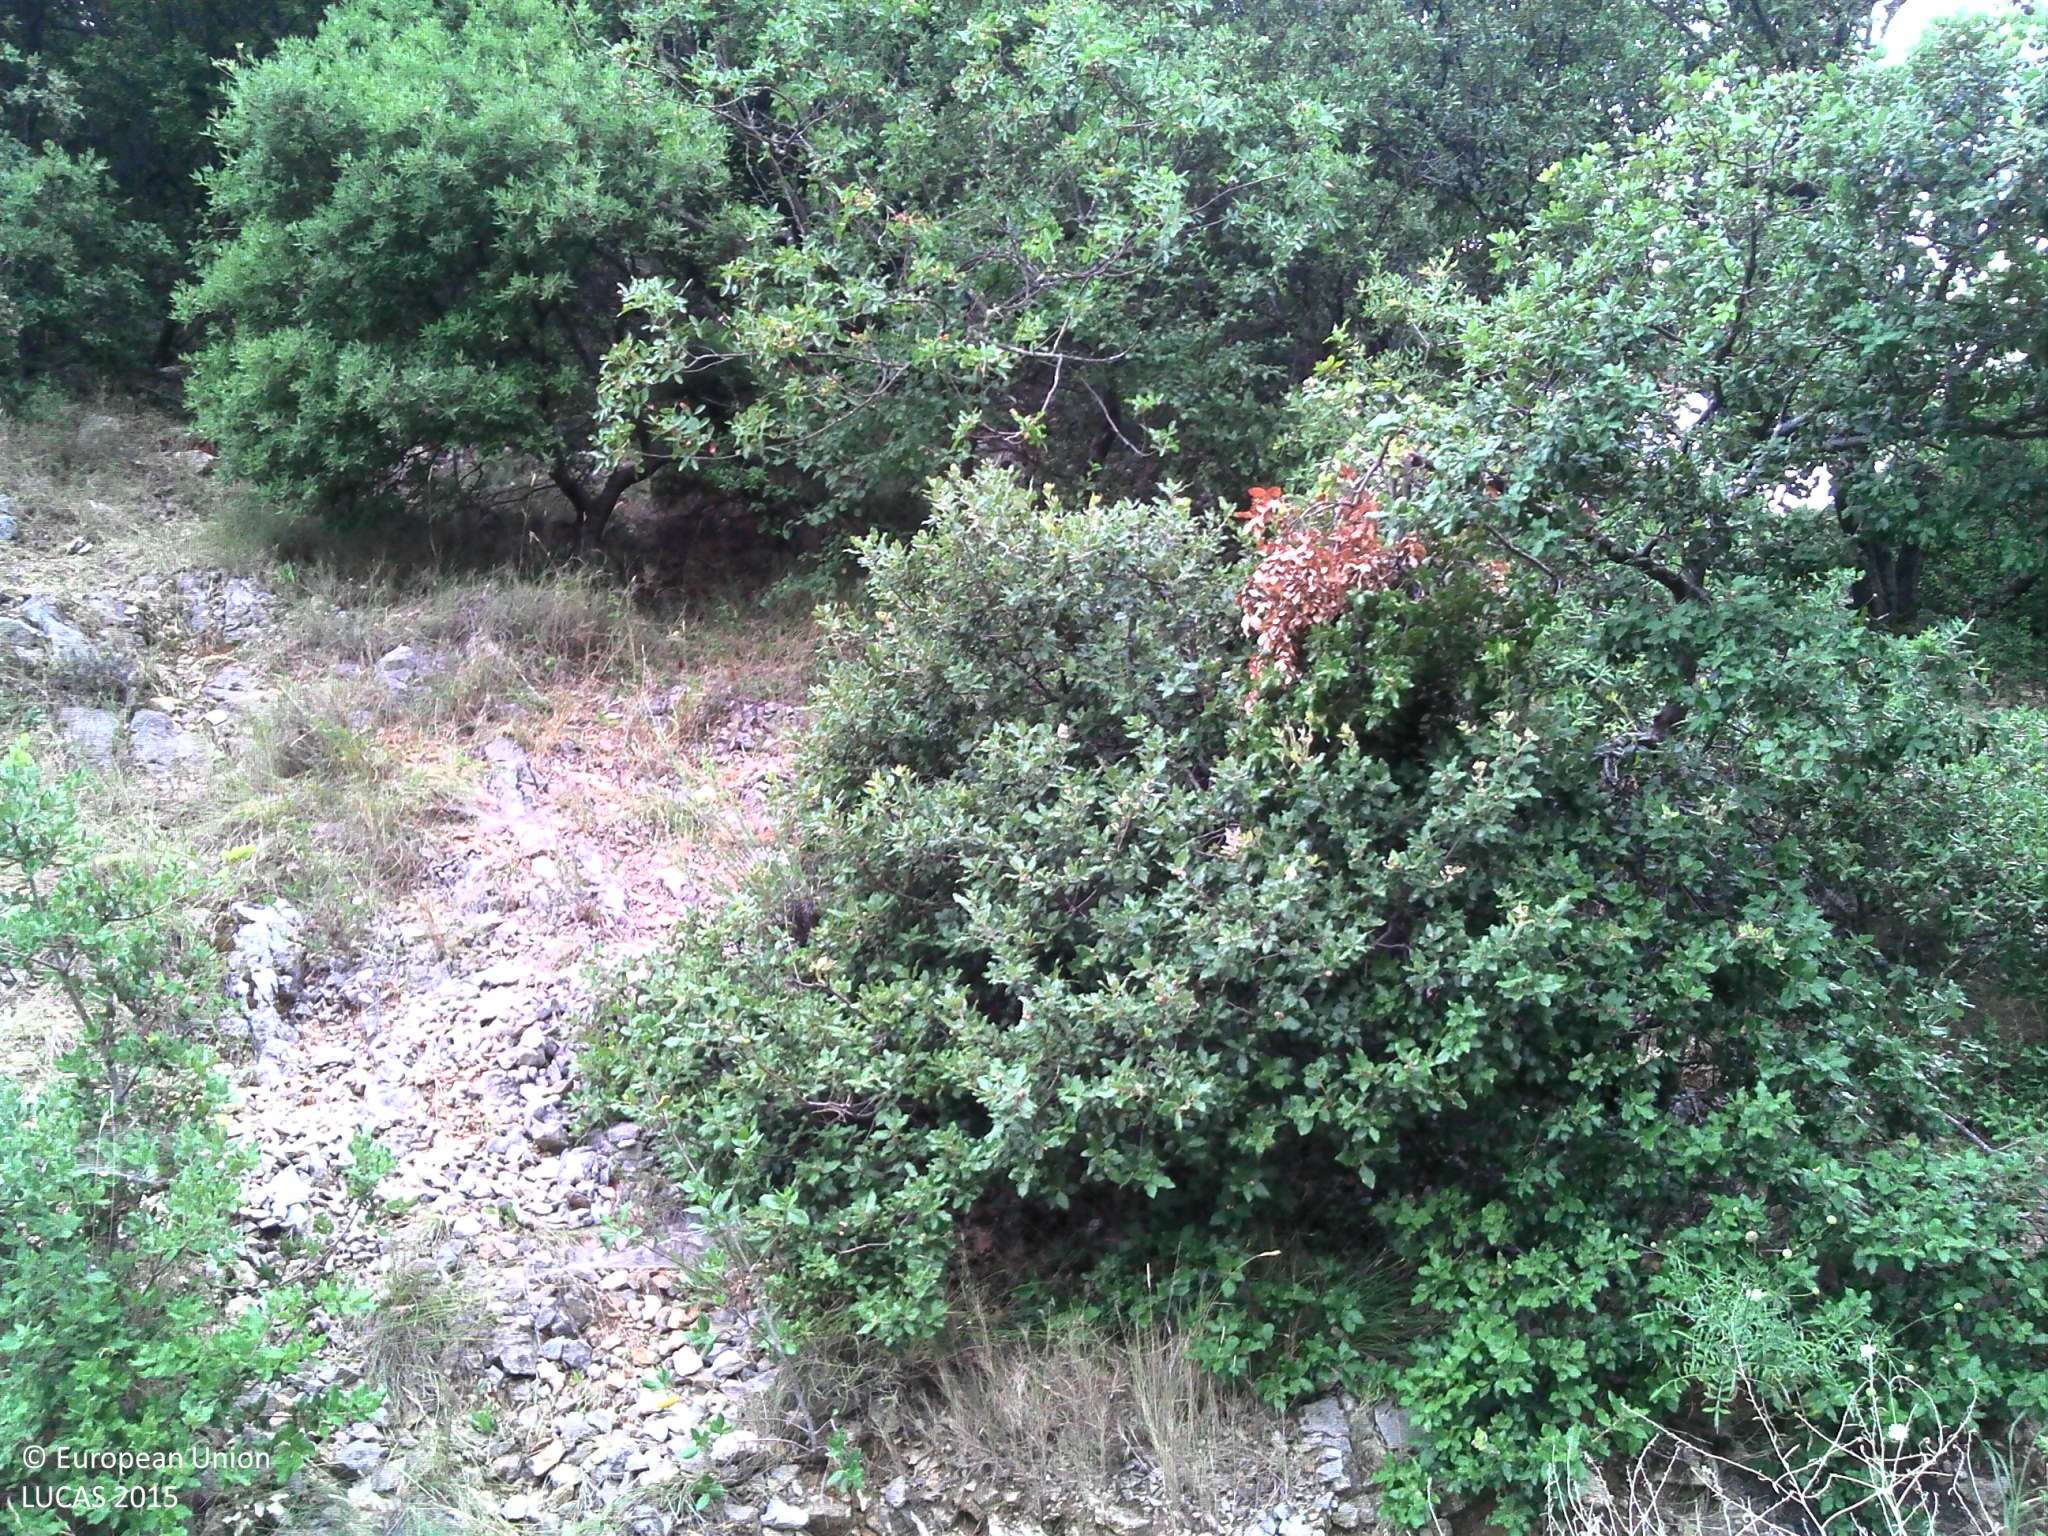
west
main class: Woodland
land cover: Broadleaved woodland
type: broadleaved evergreen forest
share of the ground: > 75 %
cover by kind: broadleaved forest trees 50 %
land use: Semi-natural and natural areas not in use
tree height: > 5 m
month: July
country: FR
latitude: 44.4458
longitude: 4.6164
